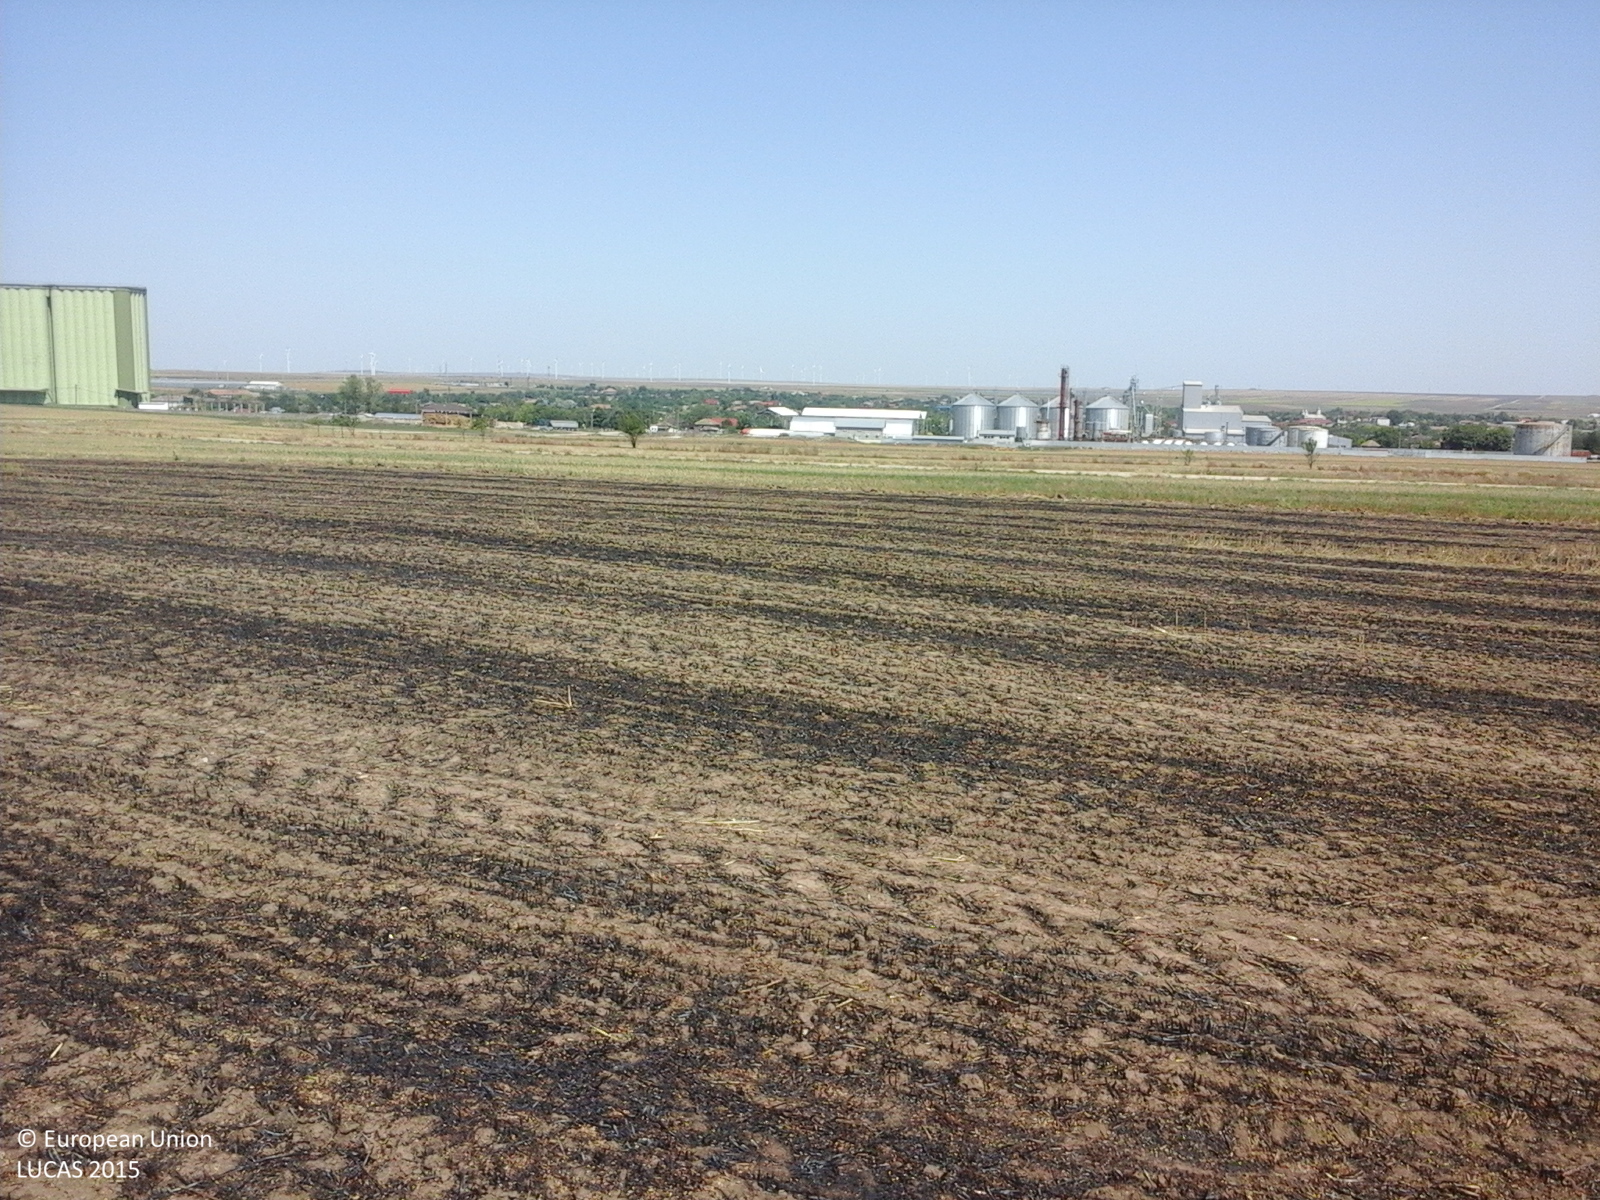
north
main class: Cropland
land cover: Common wheat
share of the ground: < 10 %
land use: Agriculture (excluding fallow land and kitchen gardens)
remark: Burnt area
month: August
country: RO
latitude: 44.3718
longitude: 28.3775
